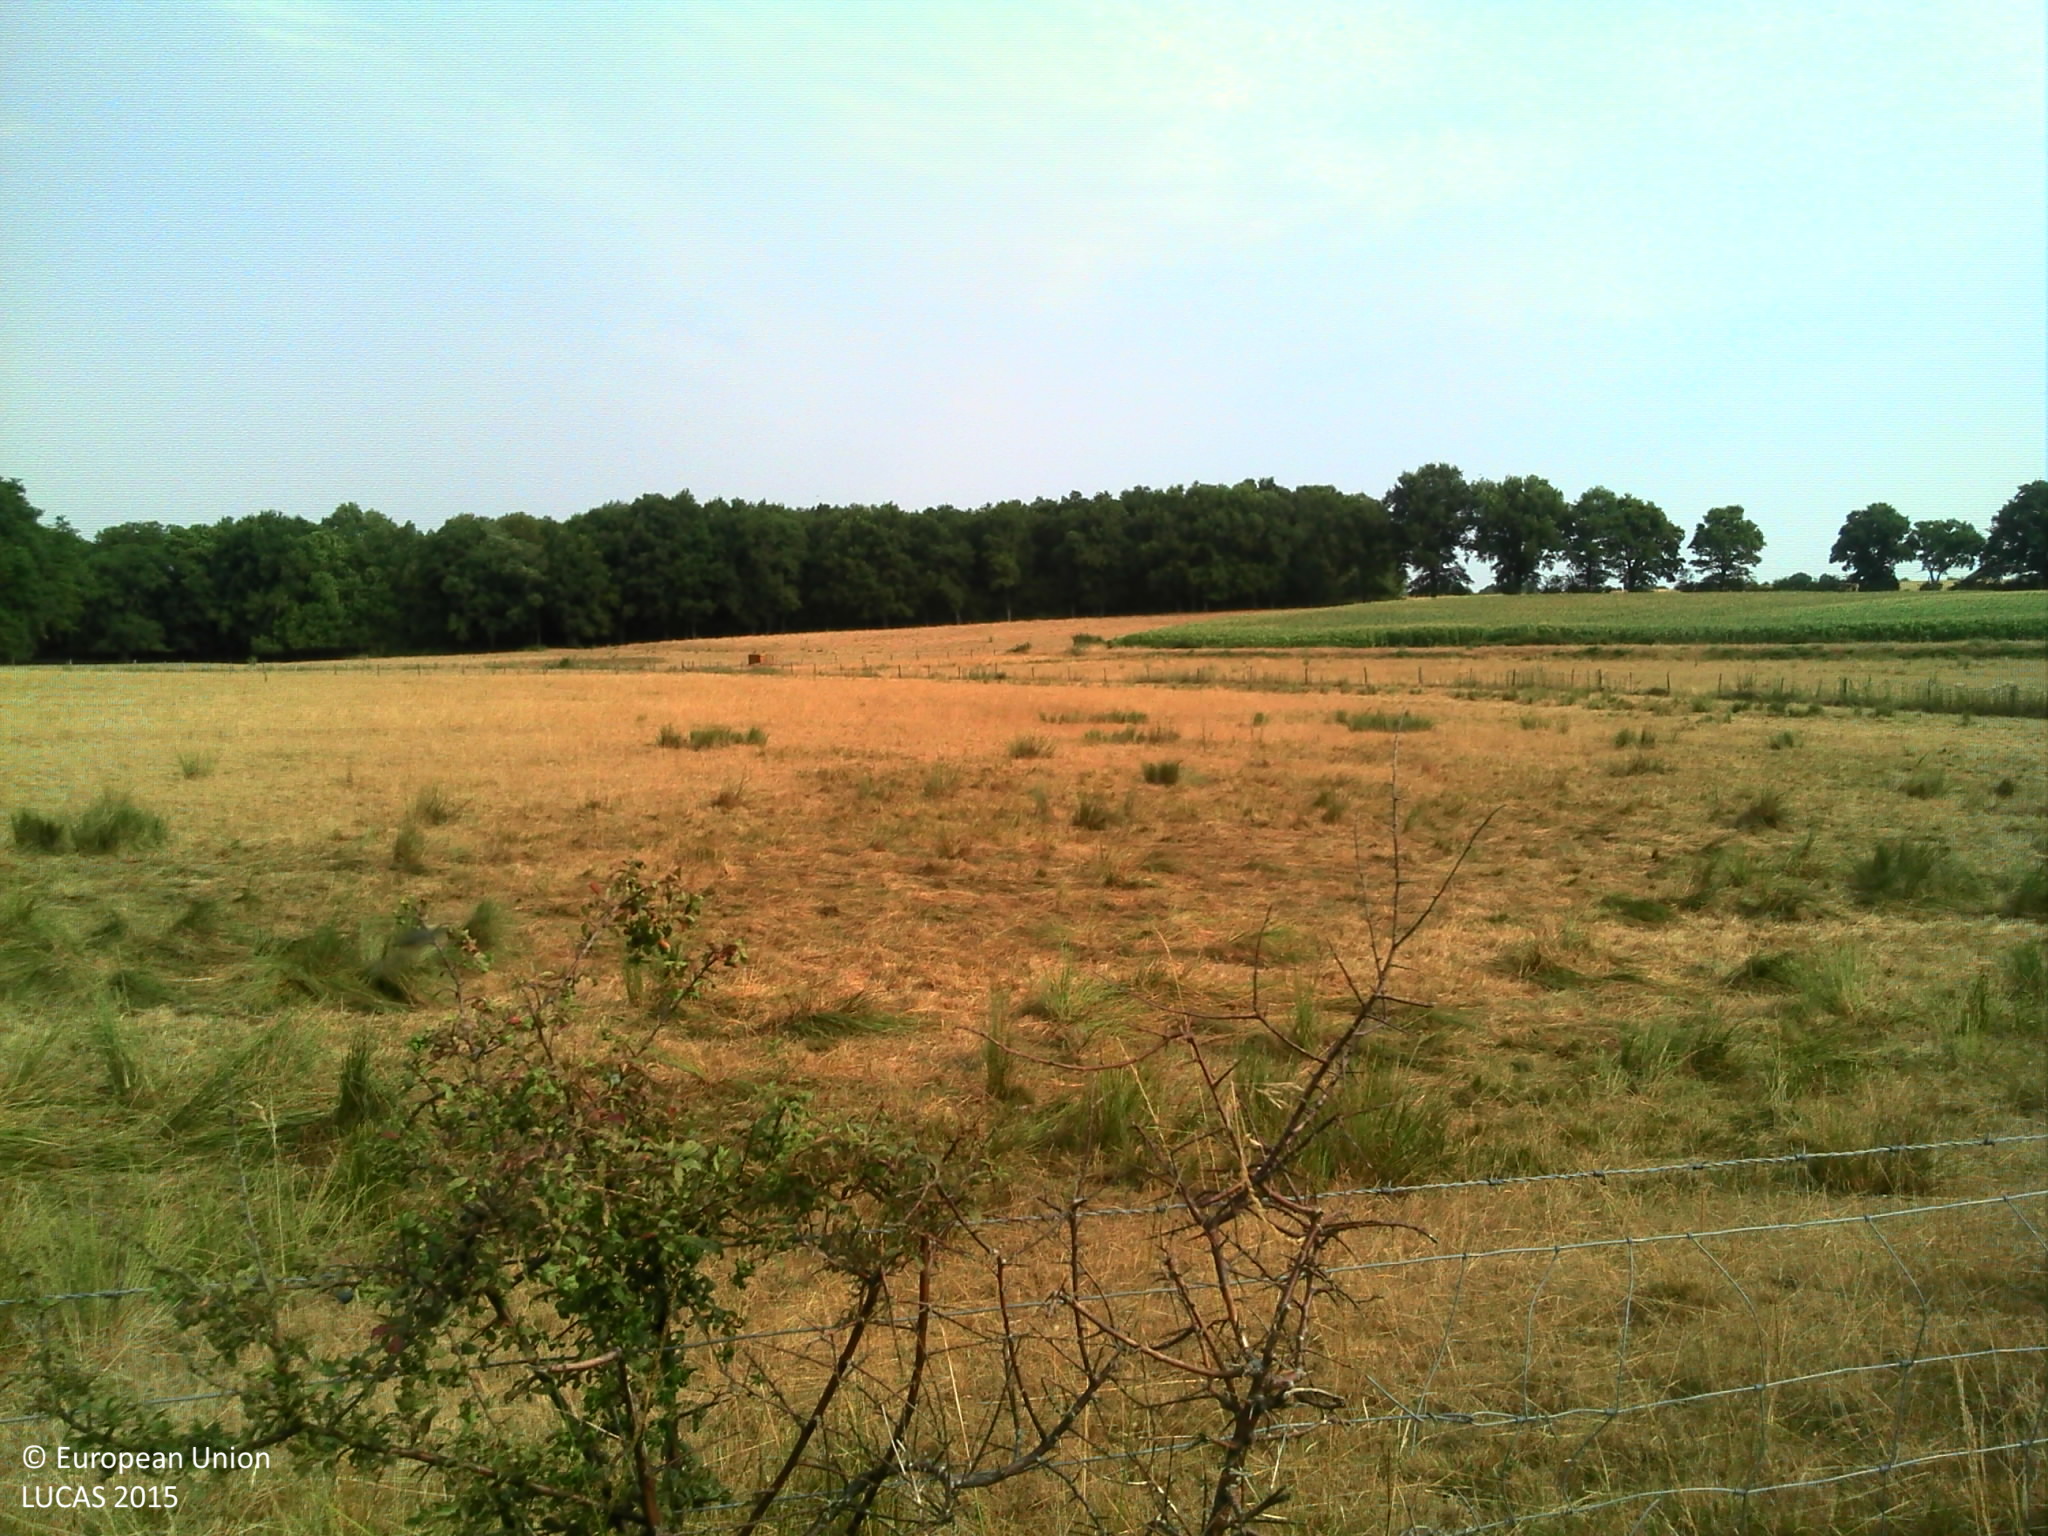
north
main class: Grassland
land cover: Grassland without tree/shrub cover
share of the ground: > 75 %
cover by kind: herbaceous plants 100 %
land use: Agriculture (excluding fallow land and kitchen gardens)
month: July
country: FR
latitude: 46.1716
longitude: 0.5941
